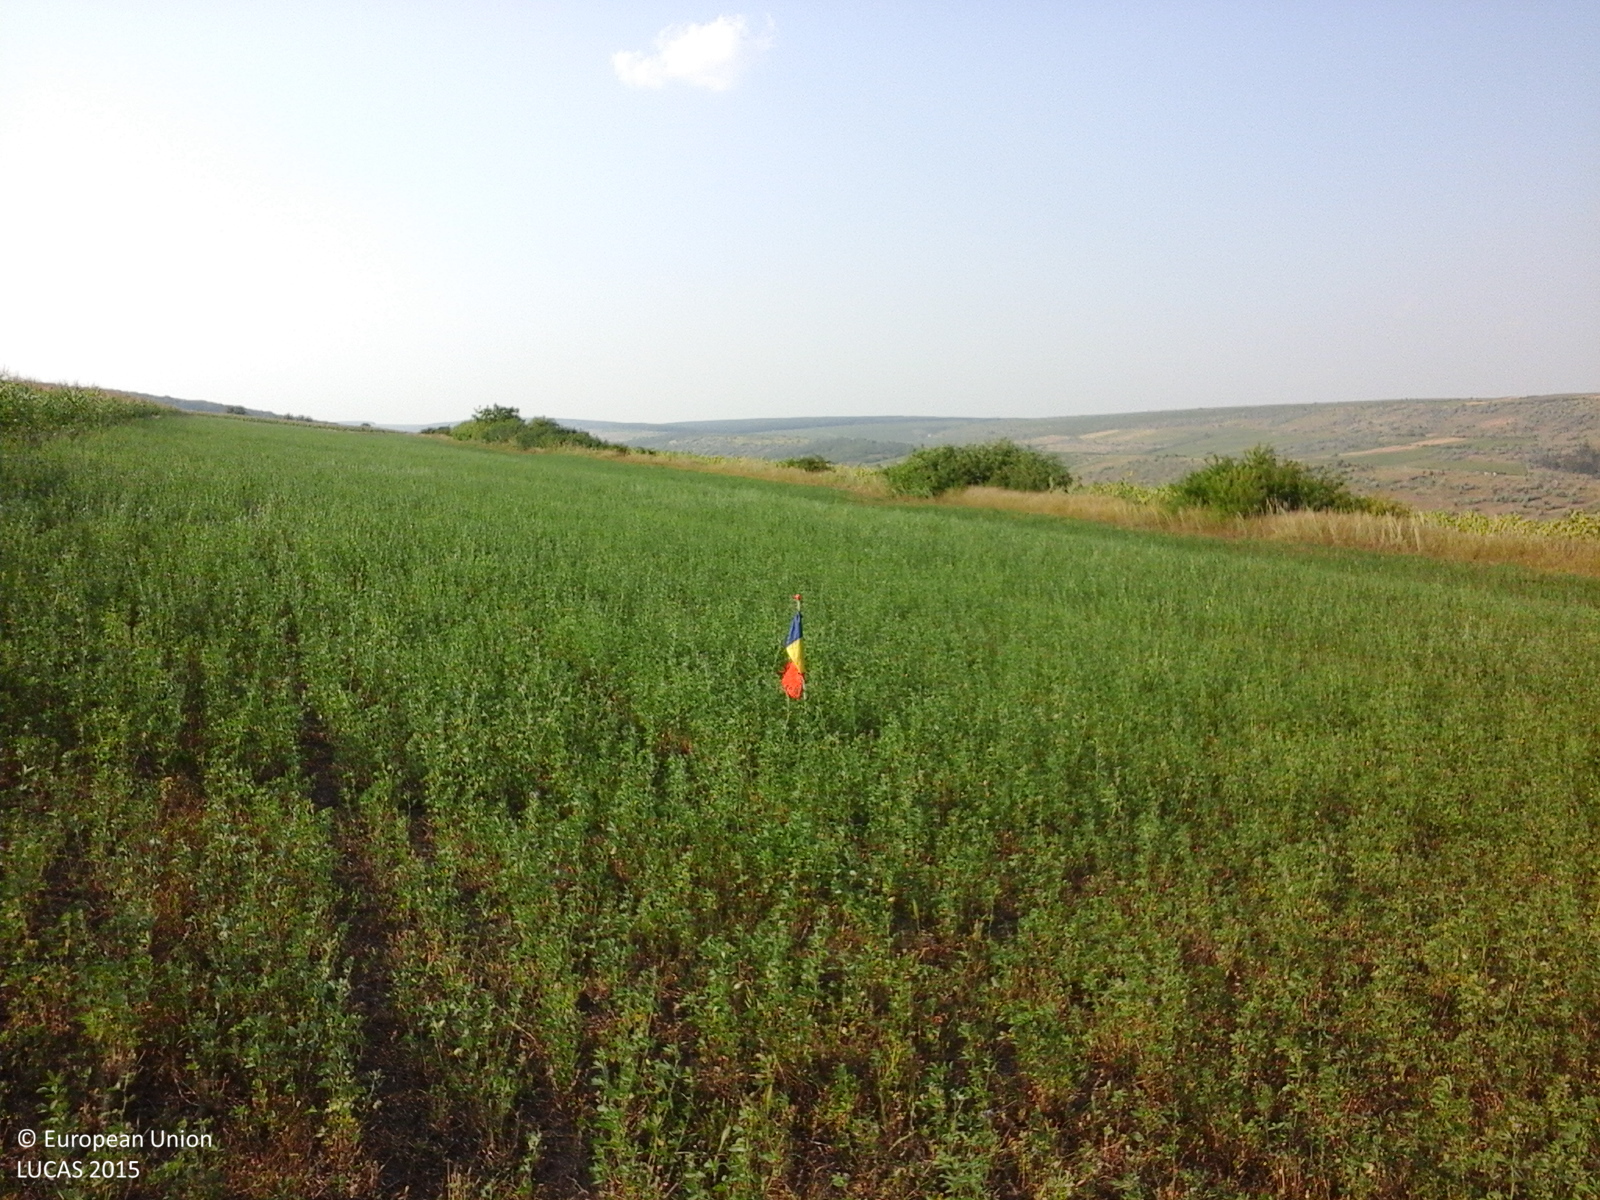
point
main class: Cropland
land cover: Lucerne
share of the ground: > 75 %
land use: Agriculture (excluding fallow land and kitchen gardens)
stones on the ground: < 10 %
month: July
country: RO
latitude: 46.3086
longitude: 27.6296
